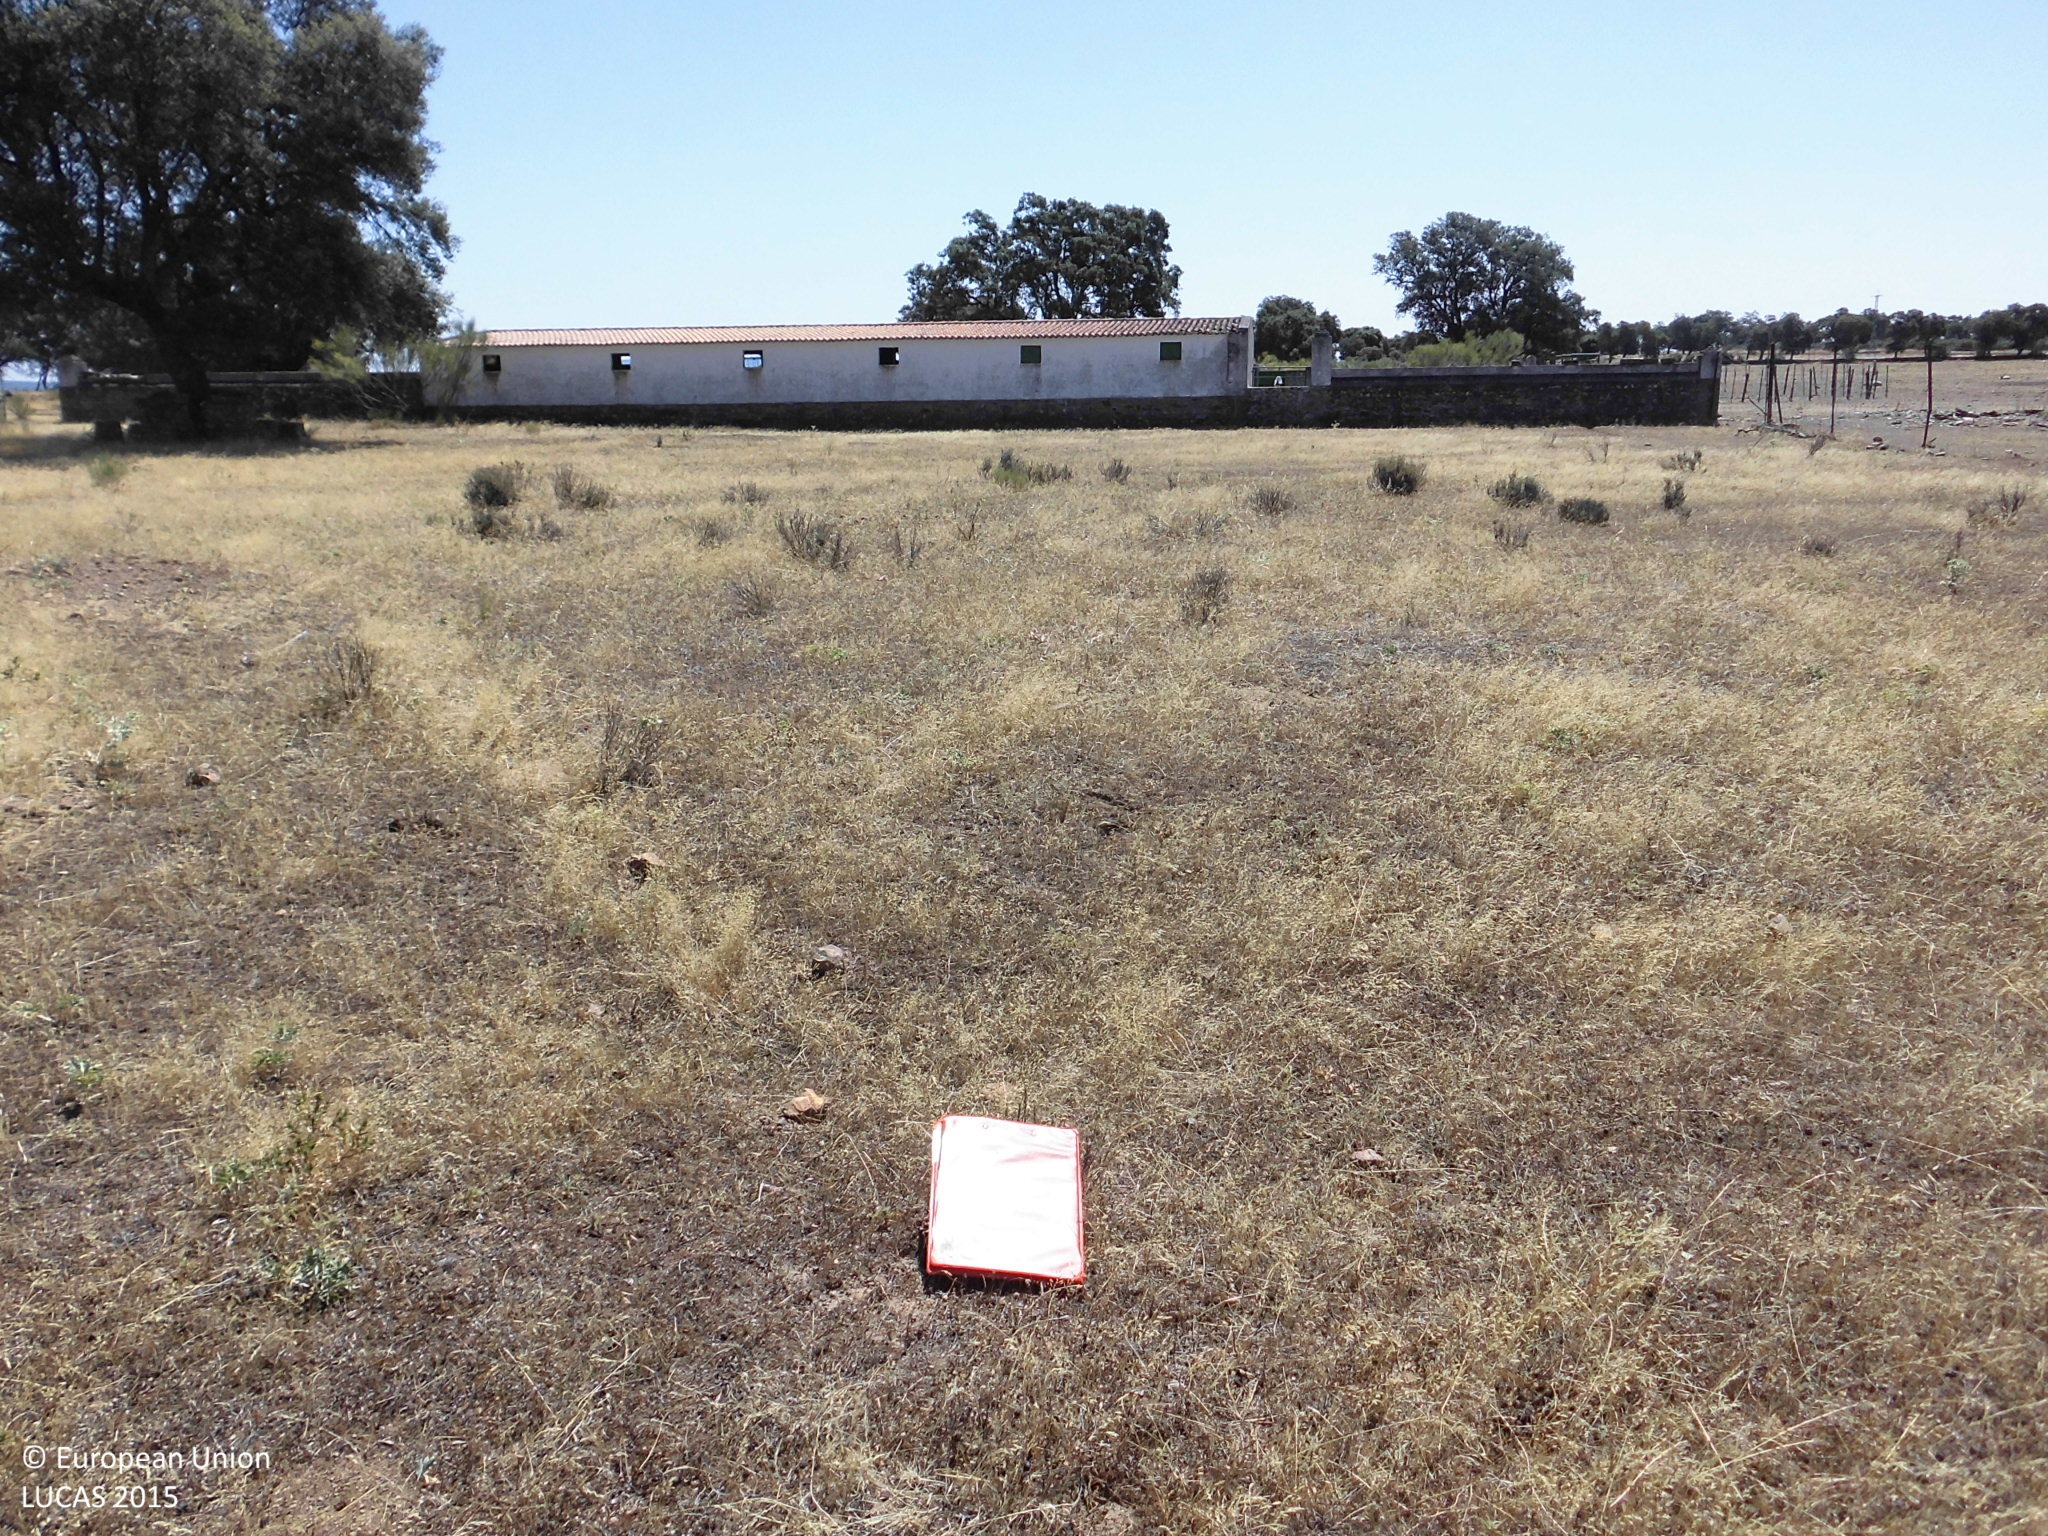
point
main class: Grassland
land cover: Grassland without tree/shrub cover
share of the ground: > 75 %
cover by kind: herbaceous plants 100 %
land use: Agriculture (excluding fallow land and kitchen gardens)
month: June
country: ES
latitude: 39.7056
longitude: -5.9609
